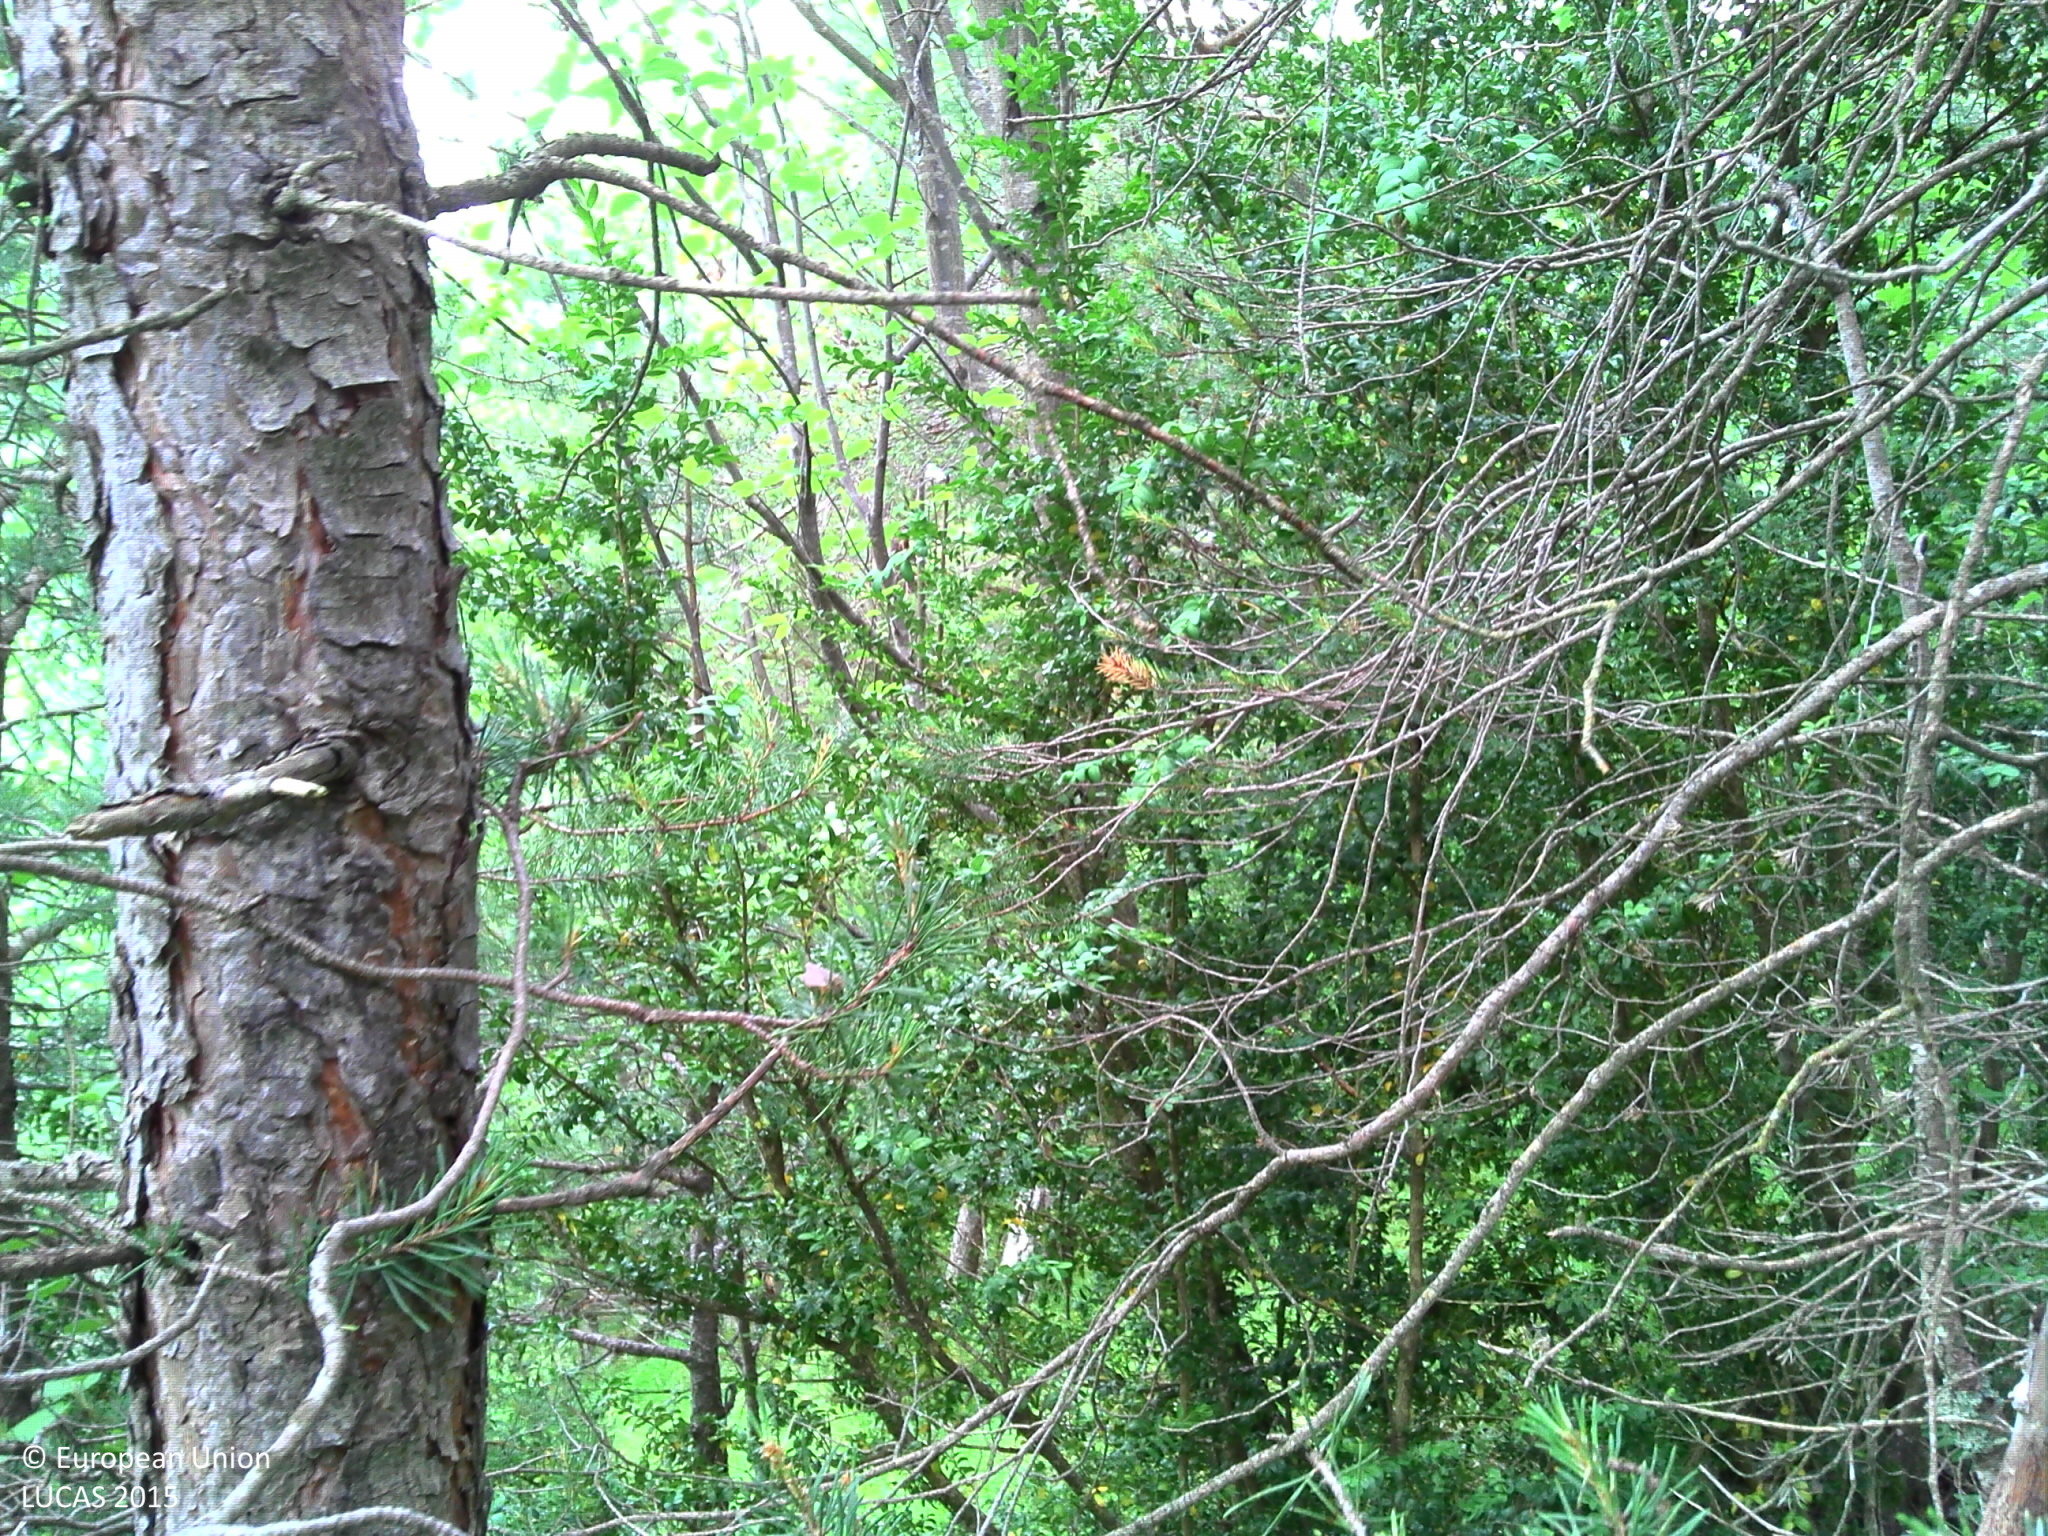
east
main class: Woodland
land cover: Pine dominated mixed woodland
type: alpine coniferous forest
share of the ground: > 75 %
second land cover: Grassland without tree/shrub cover
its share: 50 - 75 %
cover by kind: coniferous forest trees 60 %, broadleaved forest trees 20 %, herbaceous plants 15 %, shrubs 5 %
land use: Forestry
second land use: Agriculture (excluding fallow land and kitchen gardens)
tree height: > 5 m
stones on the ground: < 10 %
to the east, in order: Pine dominated mixed woodland; Grassland without tree/shrub cover; Pine dominated coniferous woodland; Grassland with sparse tree/shrub cover; Tracks; Single bushes/trees; Grassland without tree/shrub cover; Tracks; Grassland without tree/shrub cover; Single bushes/trees; Grassland without tree/shrub cover; Grassland with sparse tree/shrub cover
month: June
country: FR
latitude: 44.0393
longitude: 7.0988
